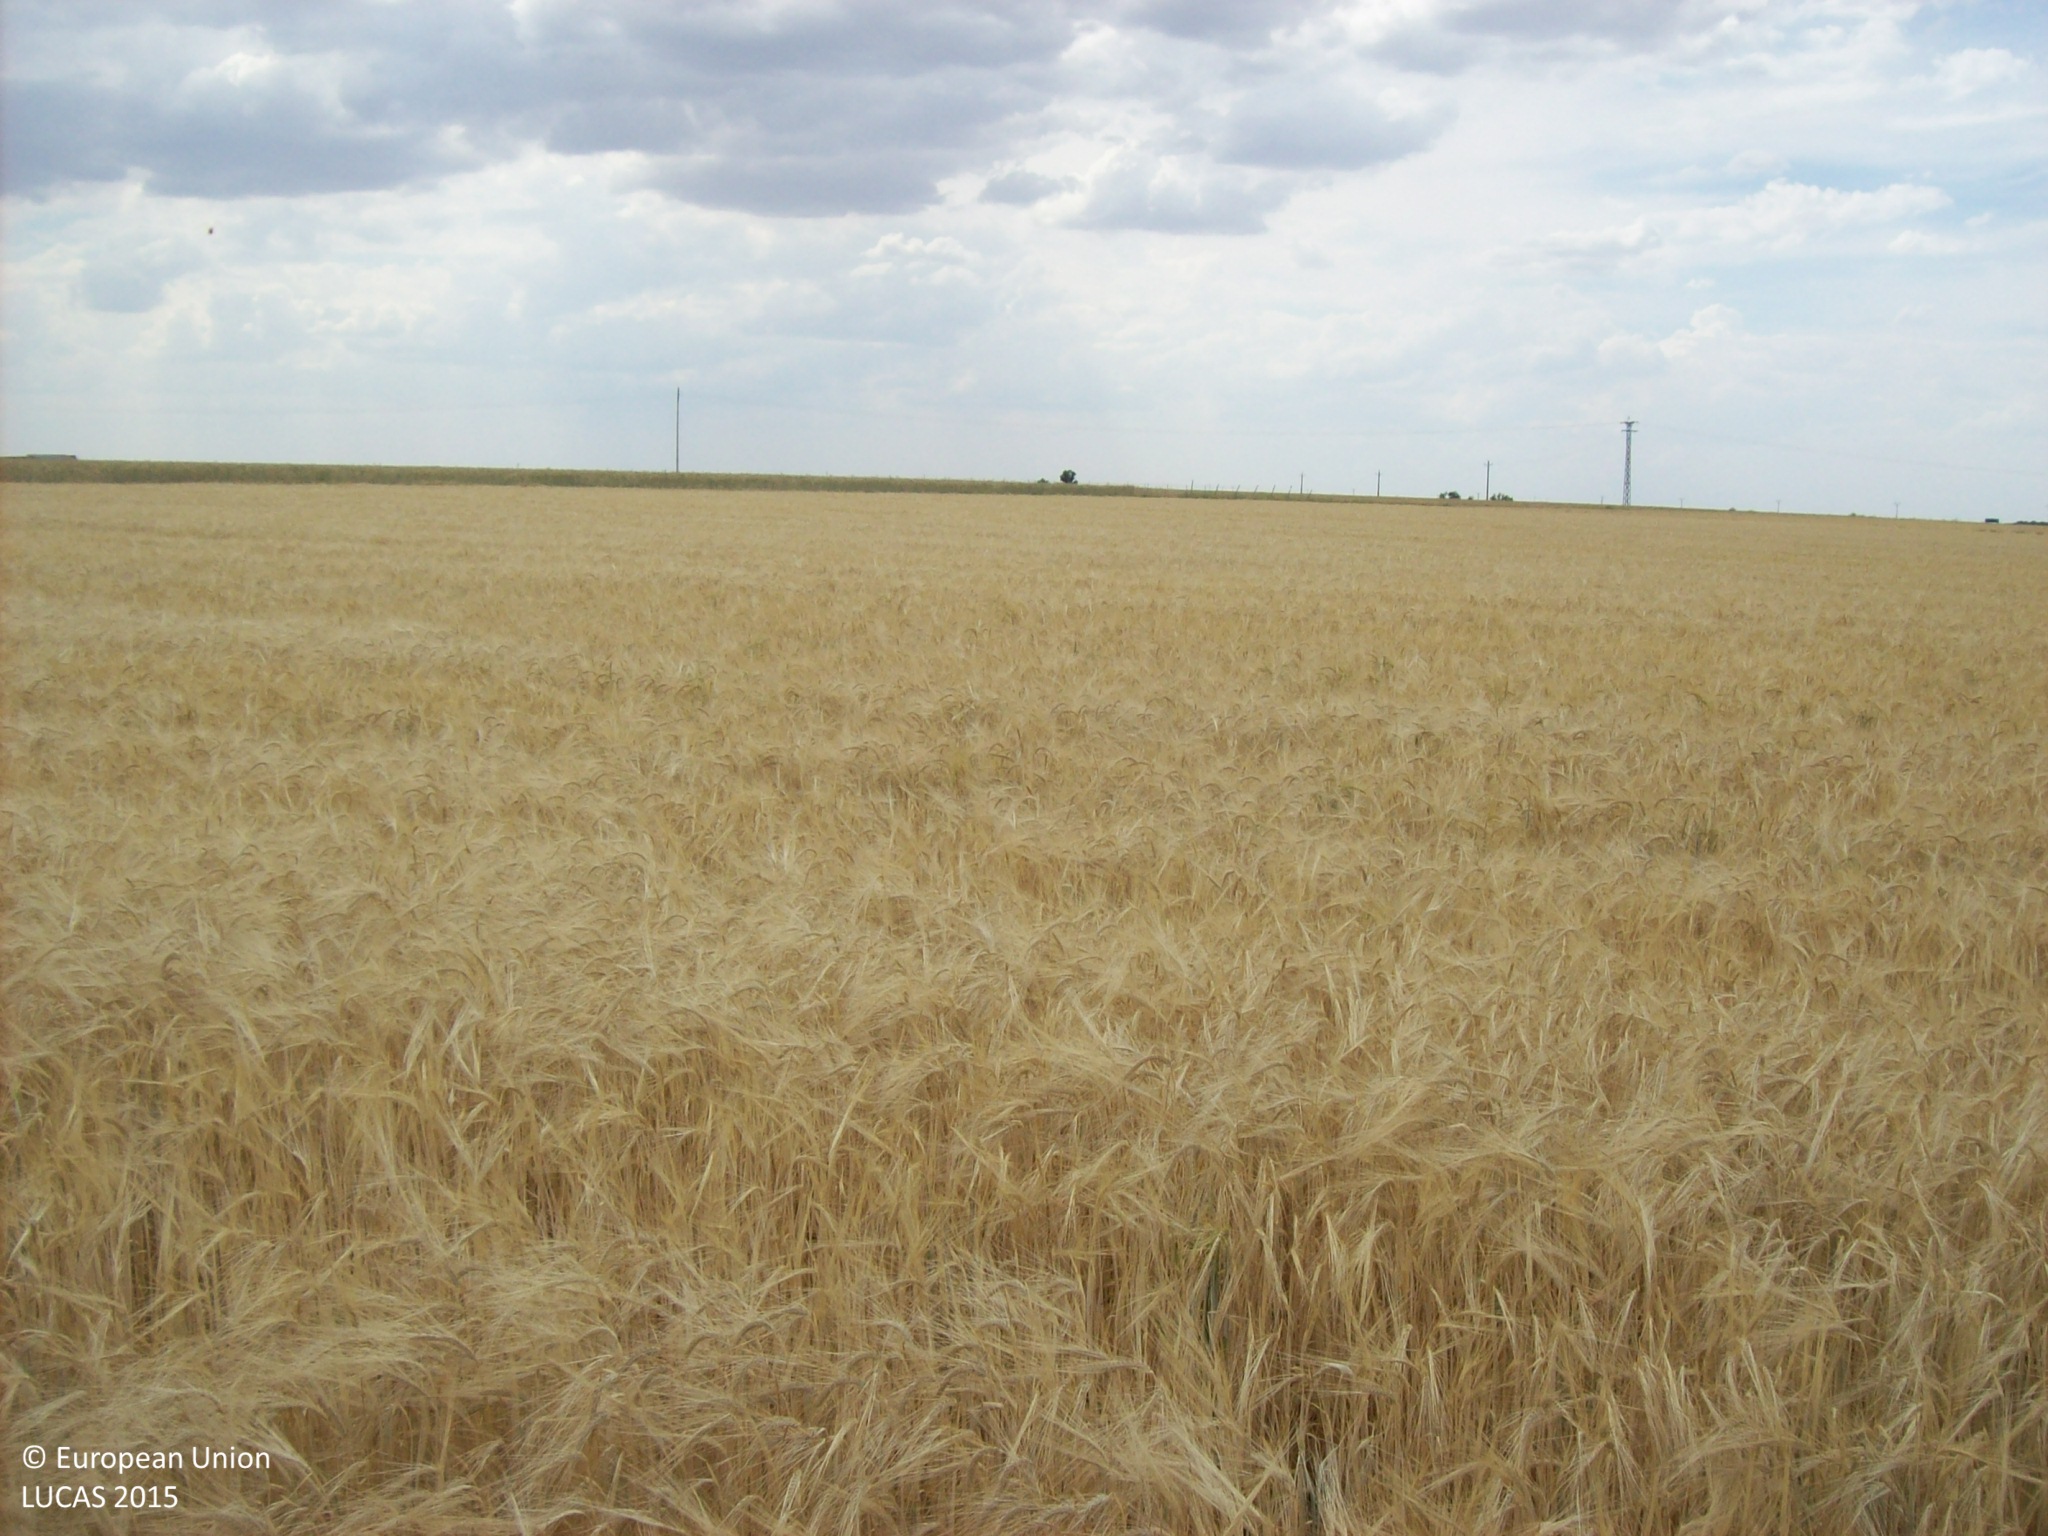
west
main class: Cropland
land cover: Barley
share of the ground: > 75 %
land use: Agriculture (excluding fallow land and kitchen gardens)
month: June
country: ES
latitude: 41.1097
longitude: -4.9877
